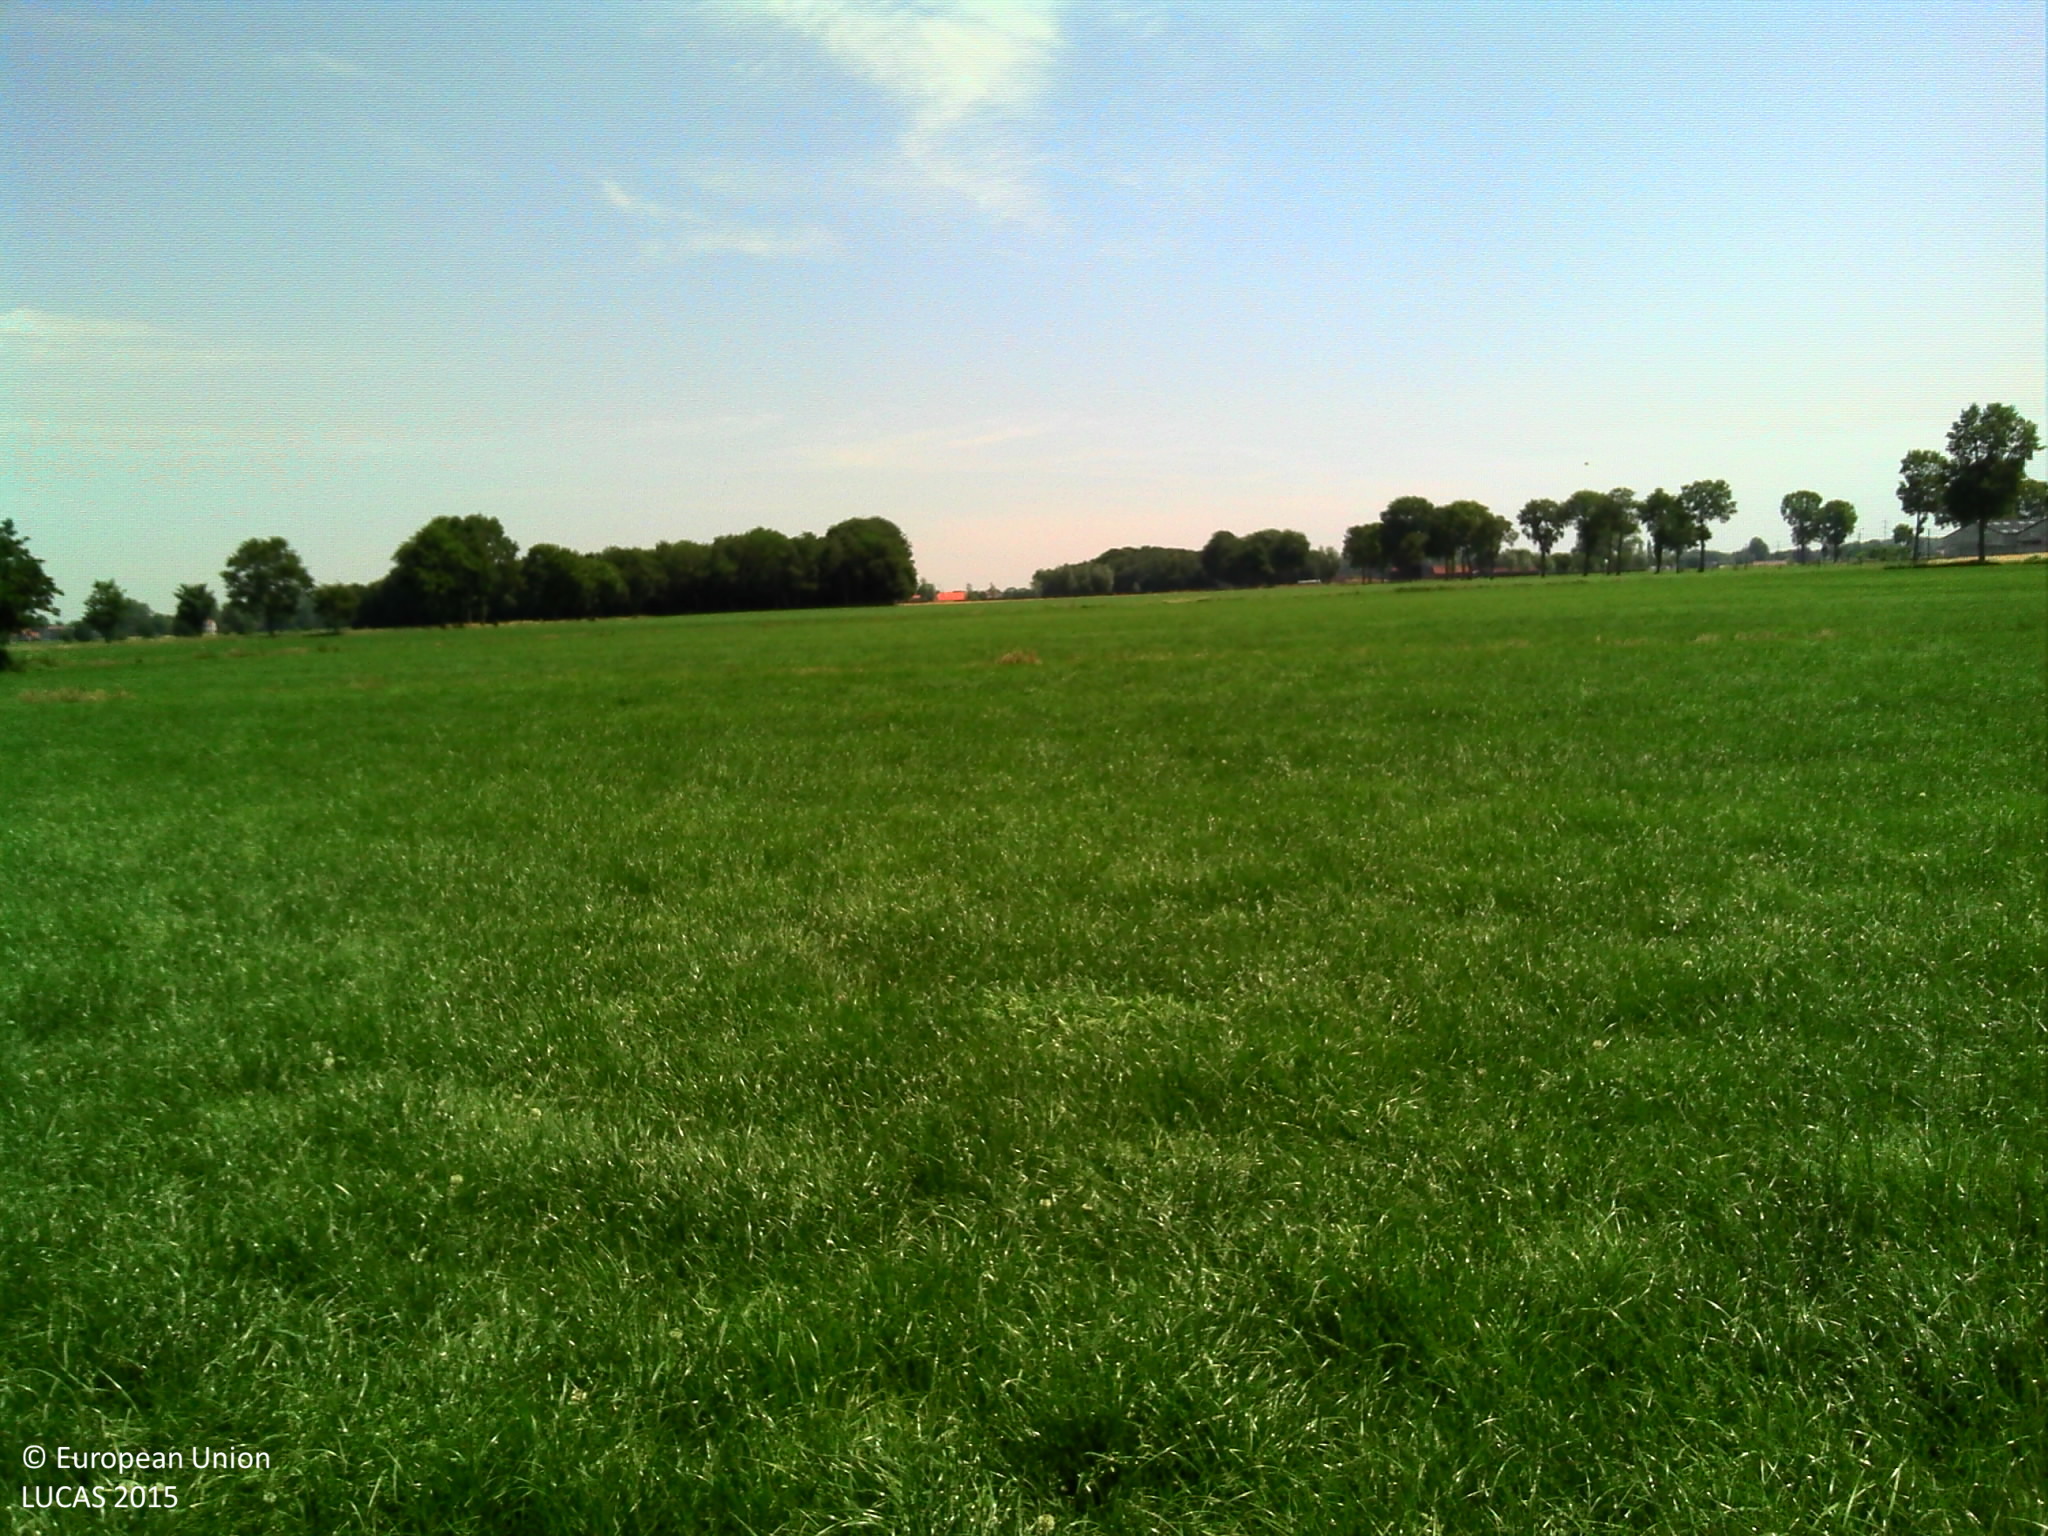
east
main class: Cropland
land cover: Temporary grasslands
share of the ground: > 75 %
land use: Agriculture (excluding fallow land and kitchen gardens)
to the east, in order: Temporary grasslands; Ditches and canals; Temporary grasslands; Ditches and canals; Temporary grasslands; Maize
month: July
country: BE
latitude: 51.2014
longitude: 3.3939
